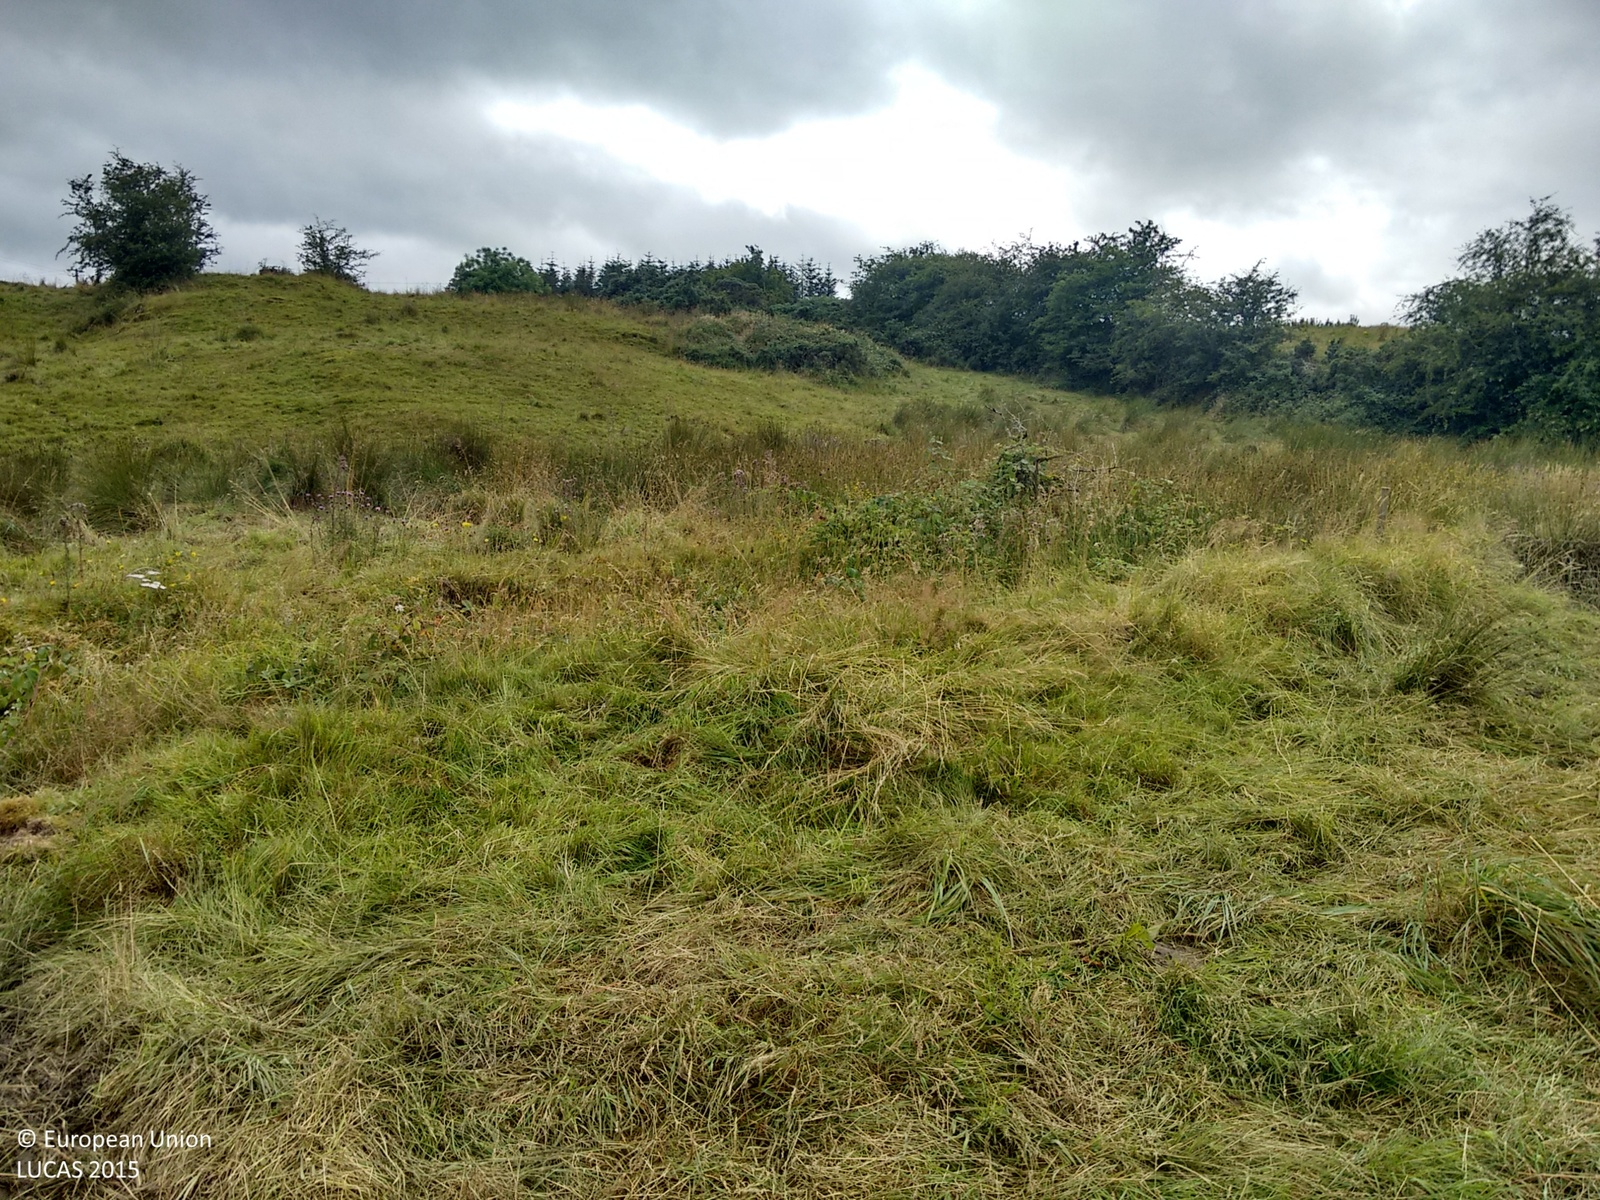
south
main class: Grassland
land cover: Grassland with sparse tree/shrub cover
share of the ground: > 75 %
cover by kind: herbaceous plants 95 %, broadleaved forest trees 5 %
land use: Agriculture (excluding fallow land and kitchen gardens)
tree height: < 5 m
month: August
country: IE
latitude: 54.0901
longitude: -6.8149
